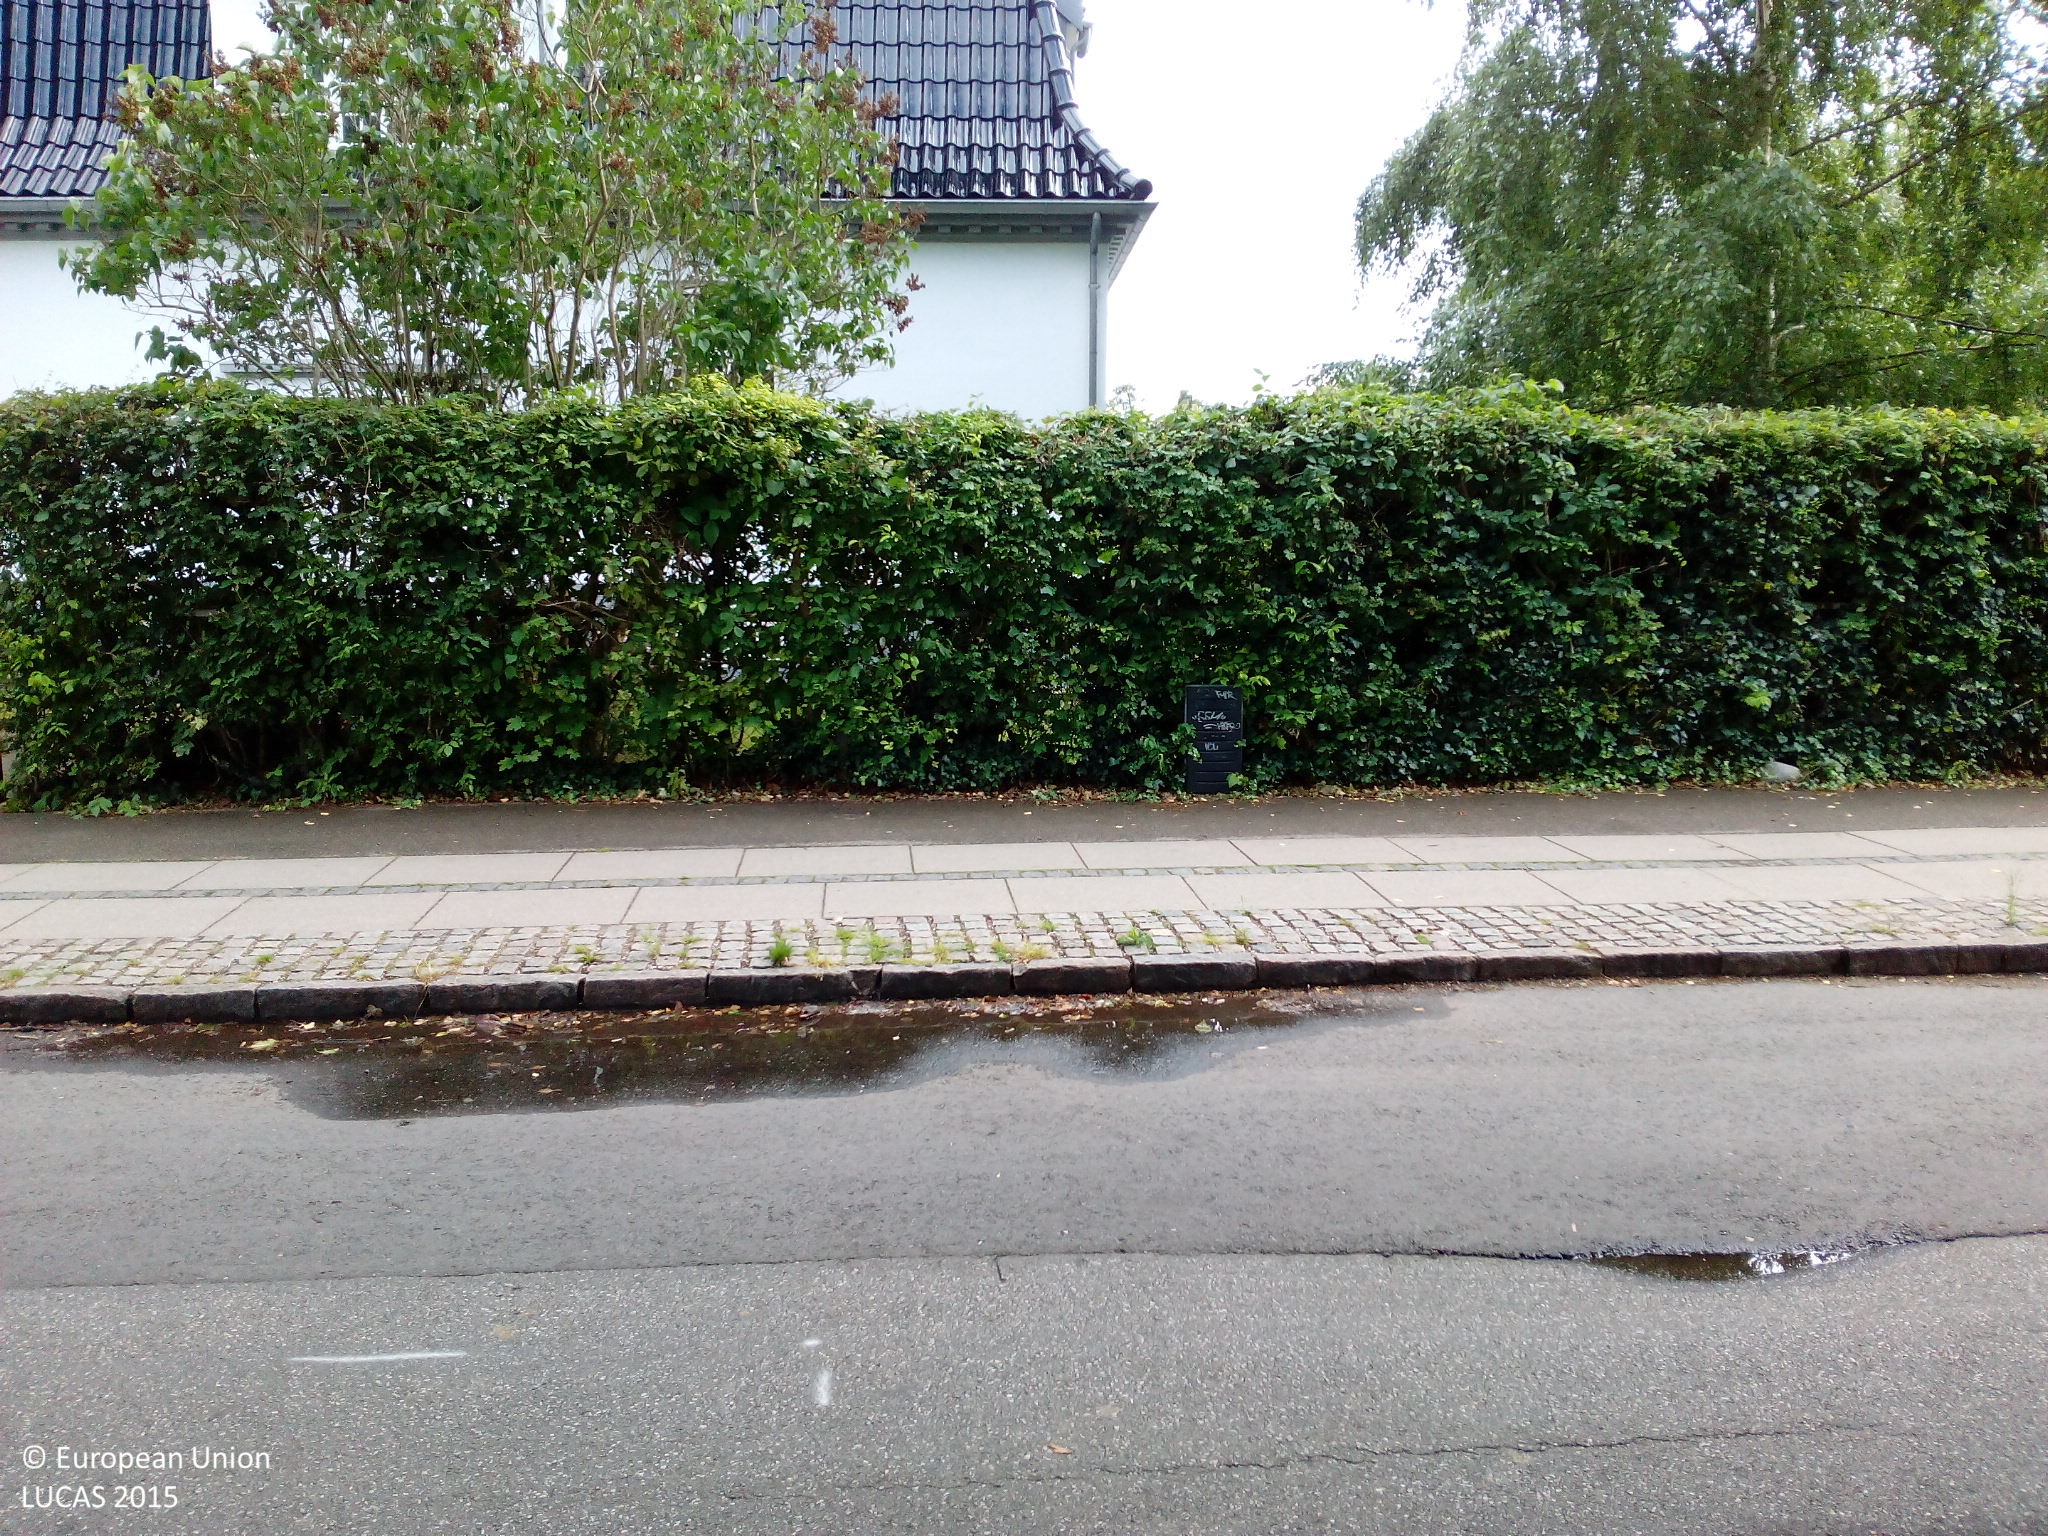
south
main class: Grassland
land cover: Grassland without tree/shrub cover
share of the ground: > 75 %
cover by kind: herbaceous plants 100 %
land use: Residential
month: July
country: DK
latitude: 55.7306
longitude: 12.5617
